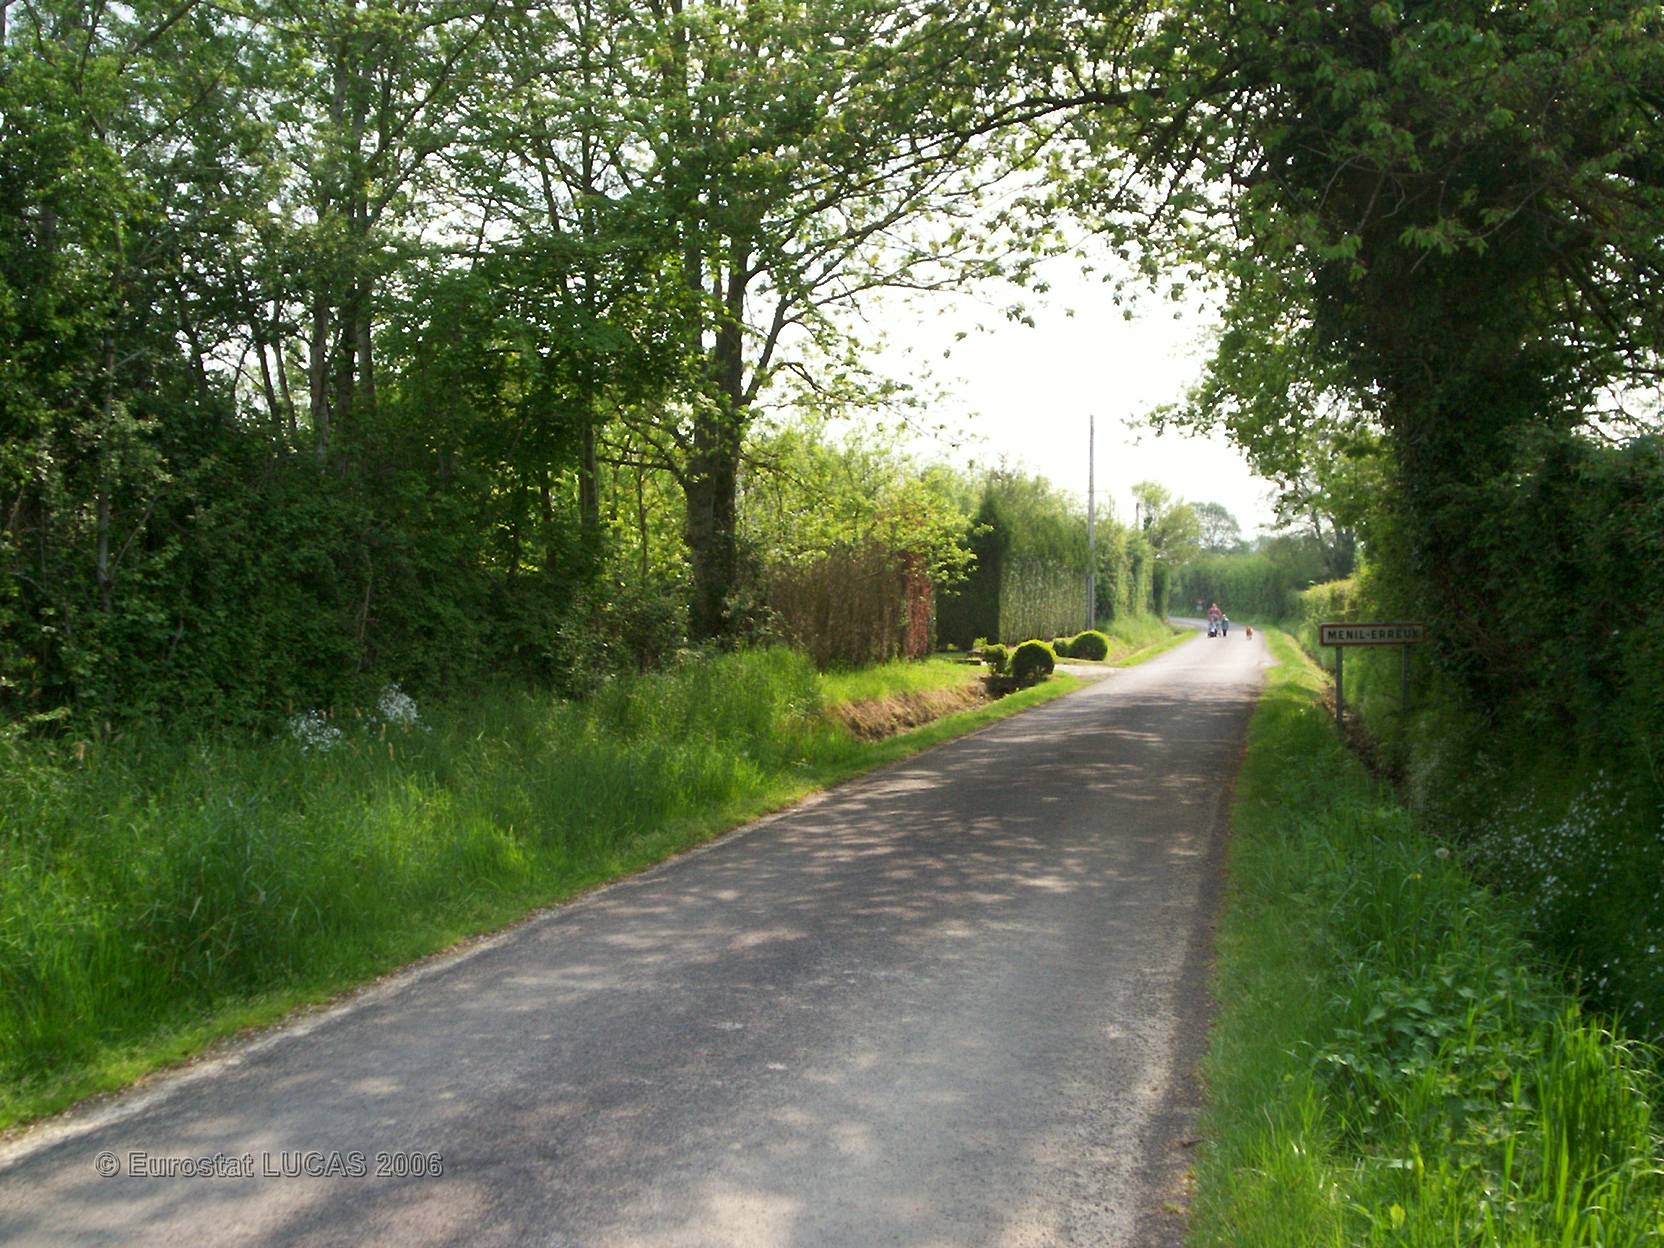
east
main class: Grassland
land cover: Grassland without tree/shrub cover
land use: Agriculture (excluding fallow land and kitchen gardens)
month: May
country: FR
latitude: 48.5096
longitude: 0.1855
